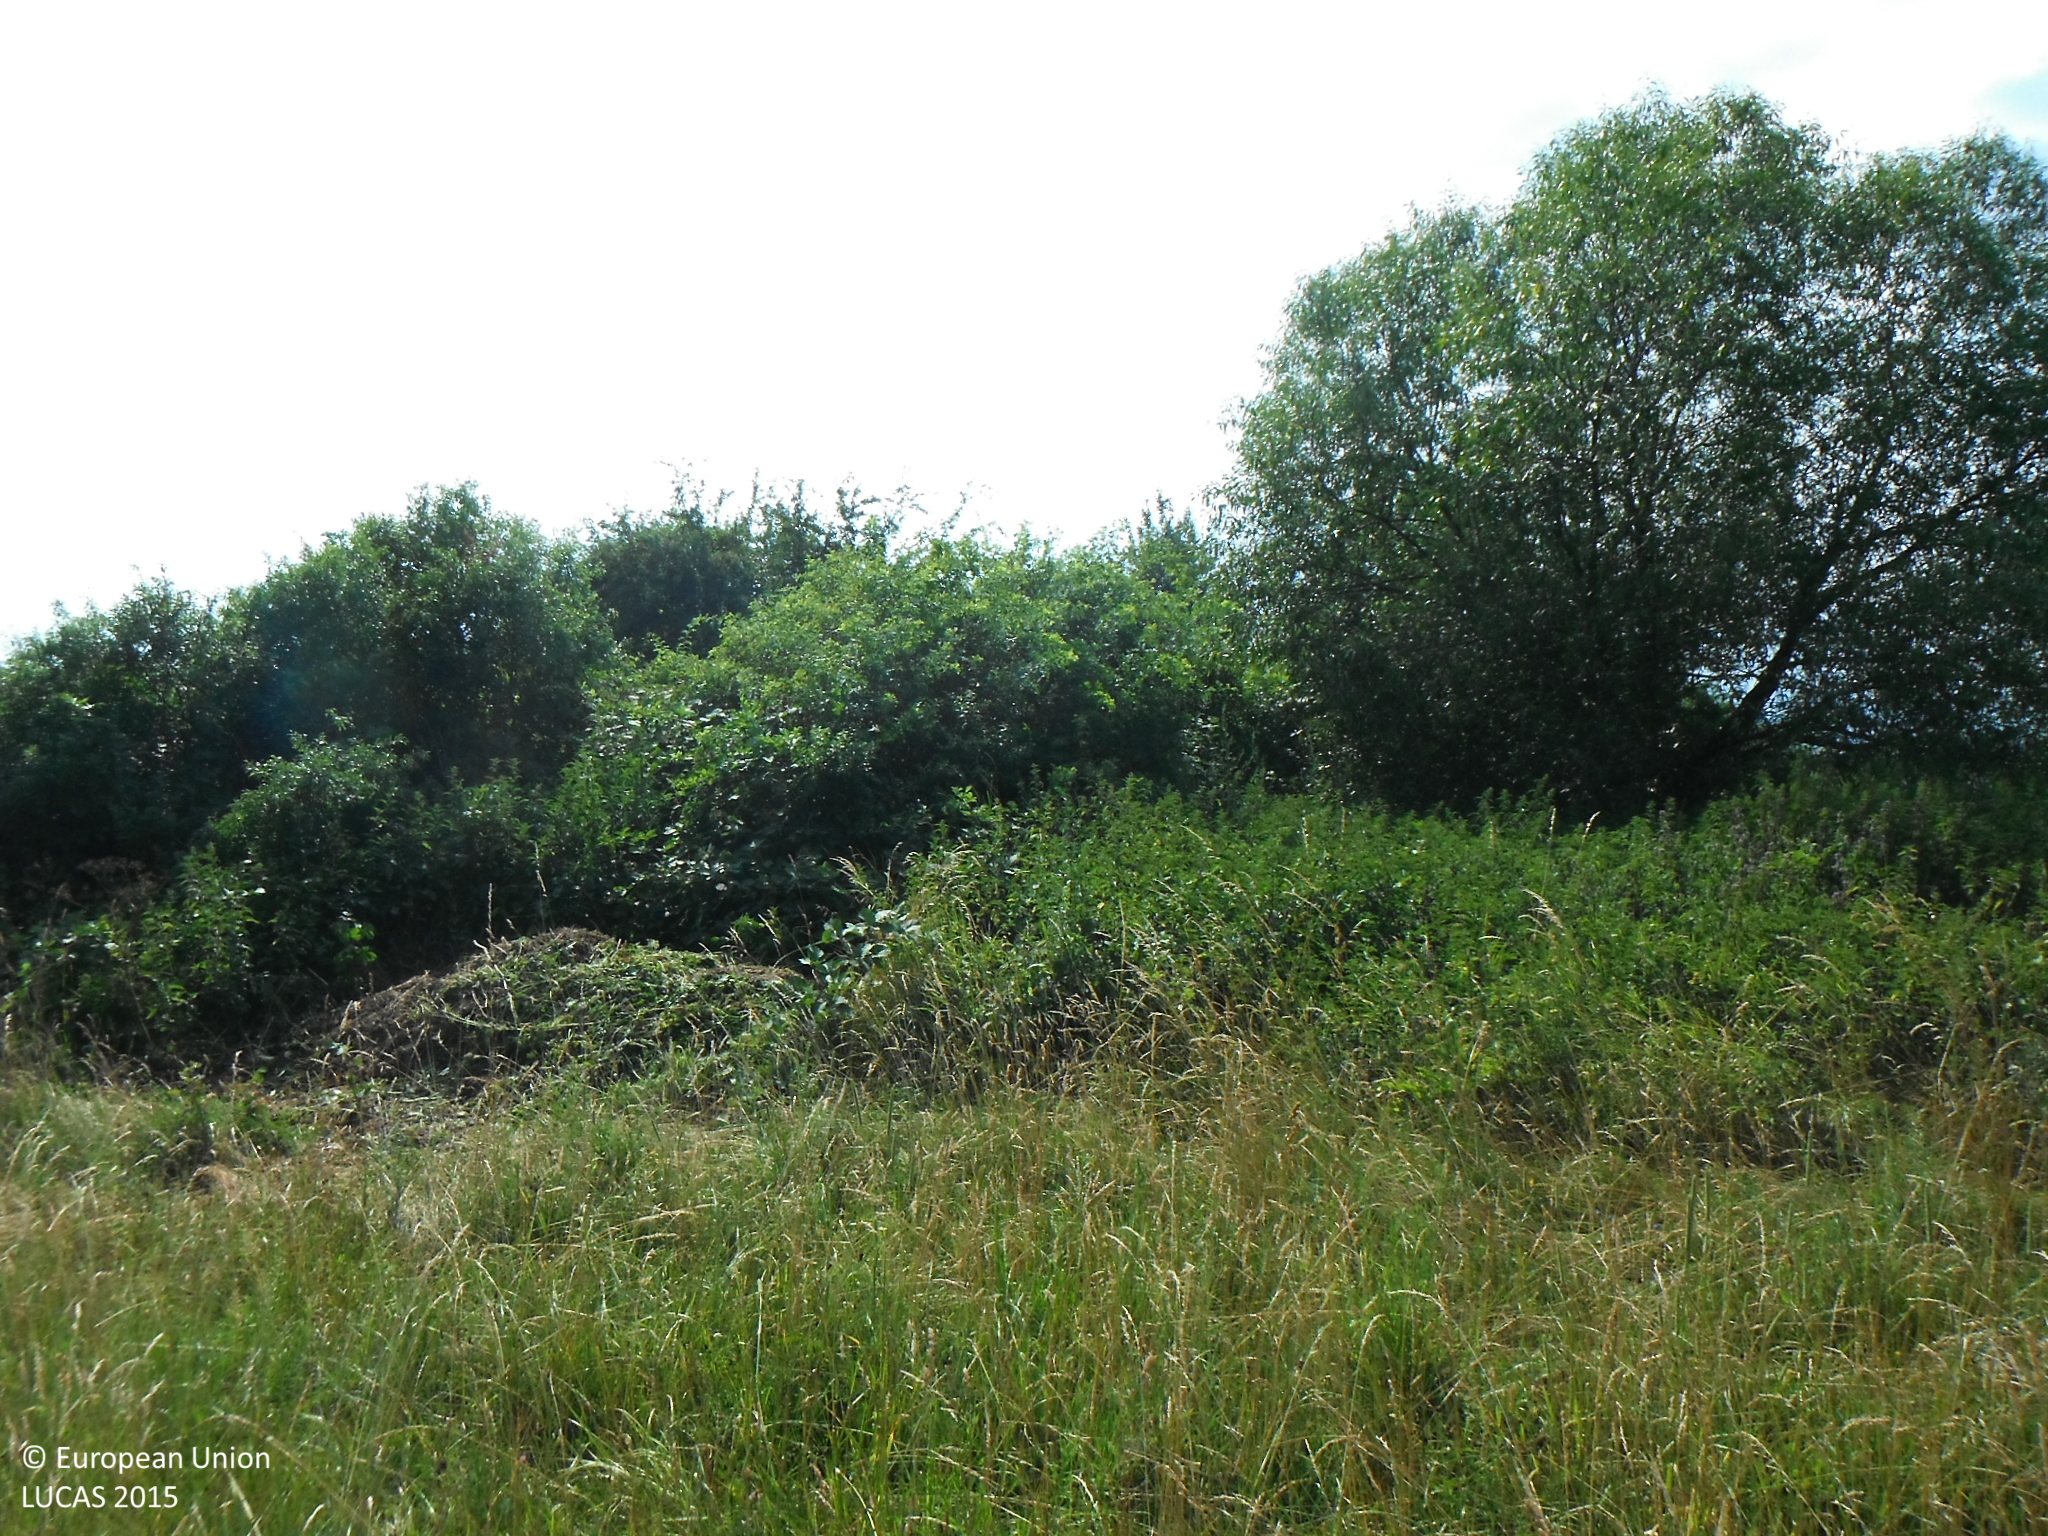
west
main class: Grassland
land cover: Grassland without tree/shrub cover
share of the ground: > 75 %
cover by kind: herbaceous plants 100 %
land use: Agriculture (excluding fallow land and kitchen gardens)
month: July
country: SK
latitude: 48.6441
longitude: 21.4337
